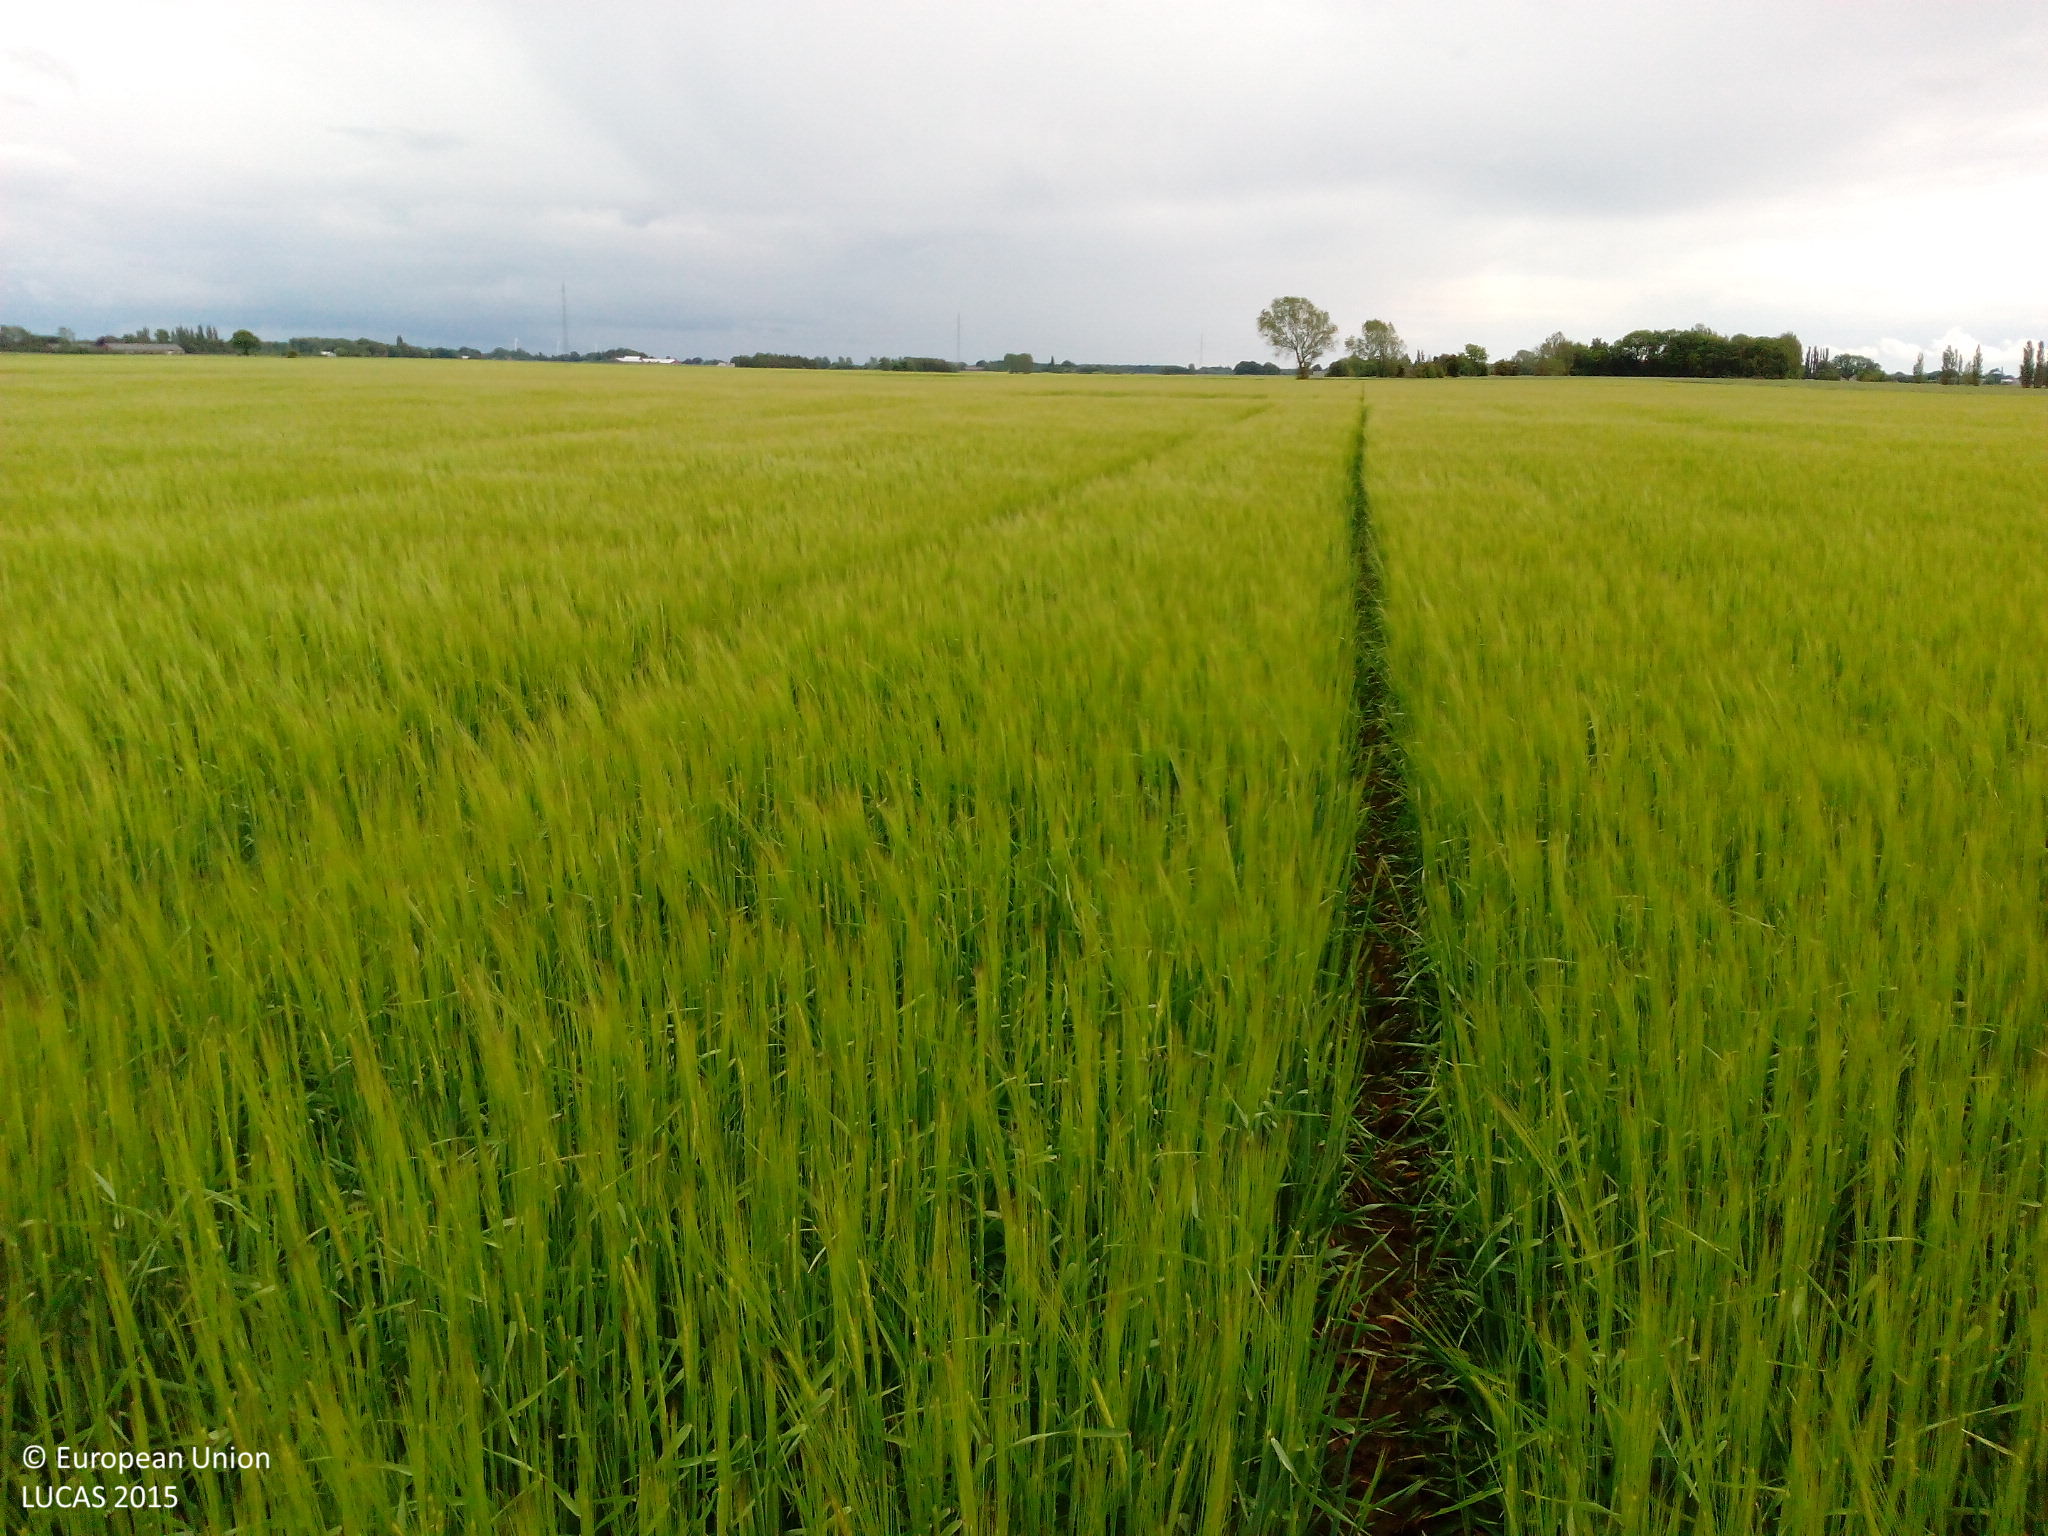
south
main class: Cropland
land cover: Barley
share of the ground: > 75 %
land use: Agriculture (excluding fallow land and kitchen gardens)
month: June
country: DK
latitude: 54.8876
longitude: 11.2307
